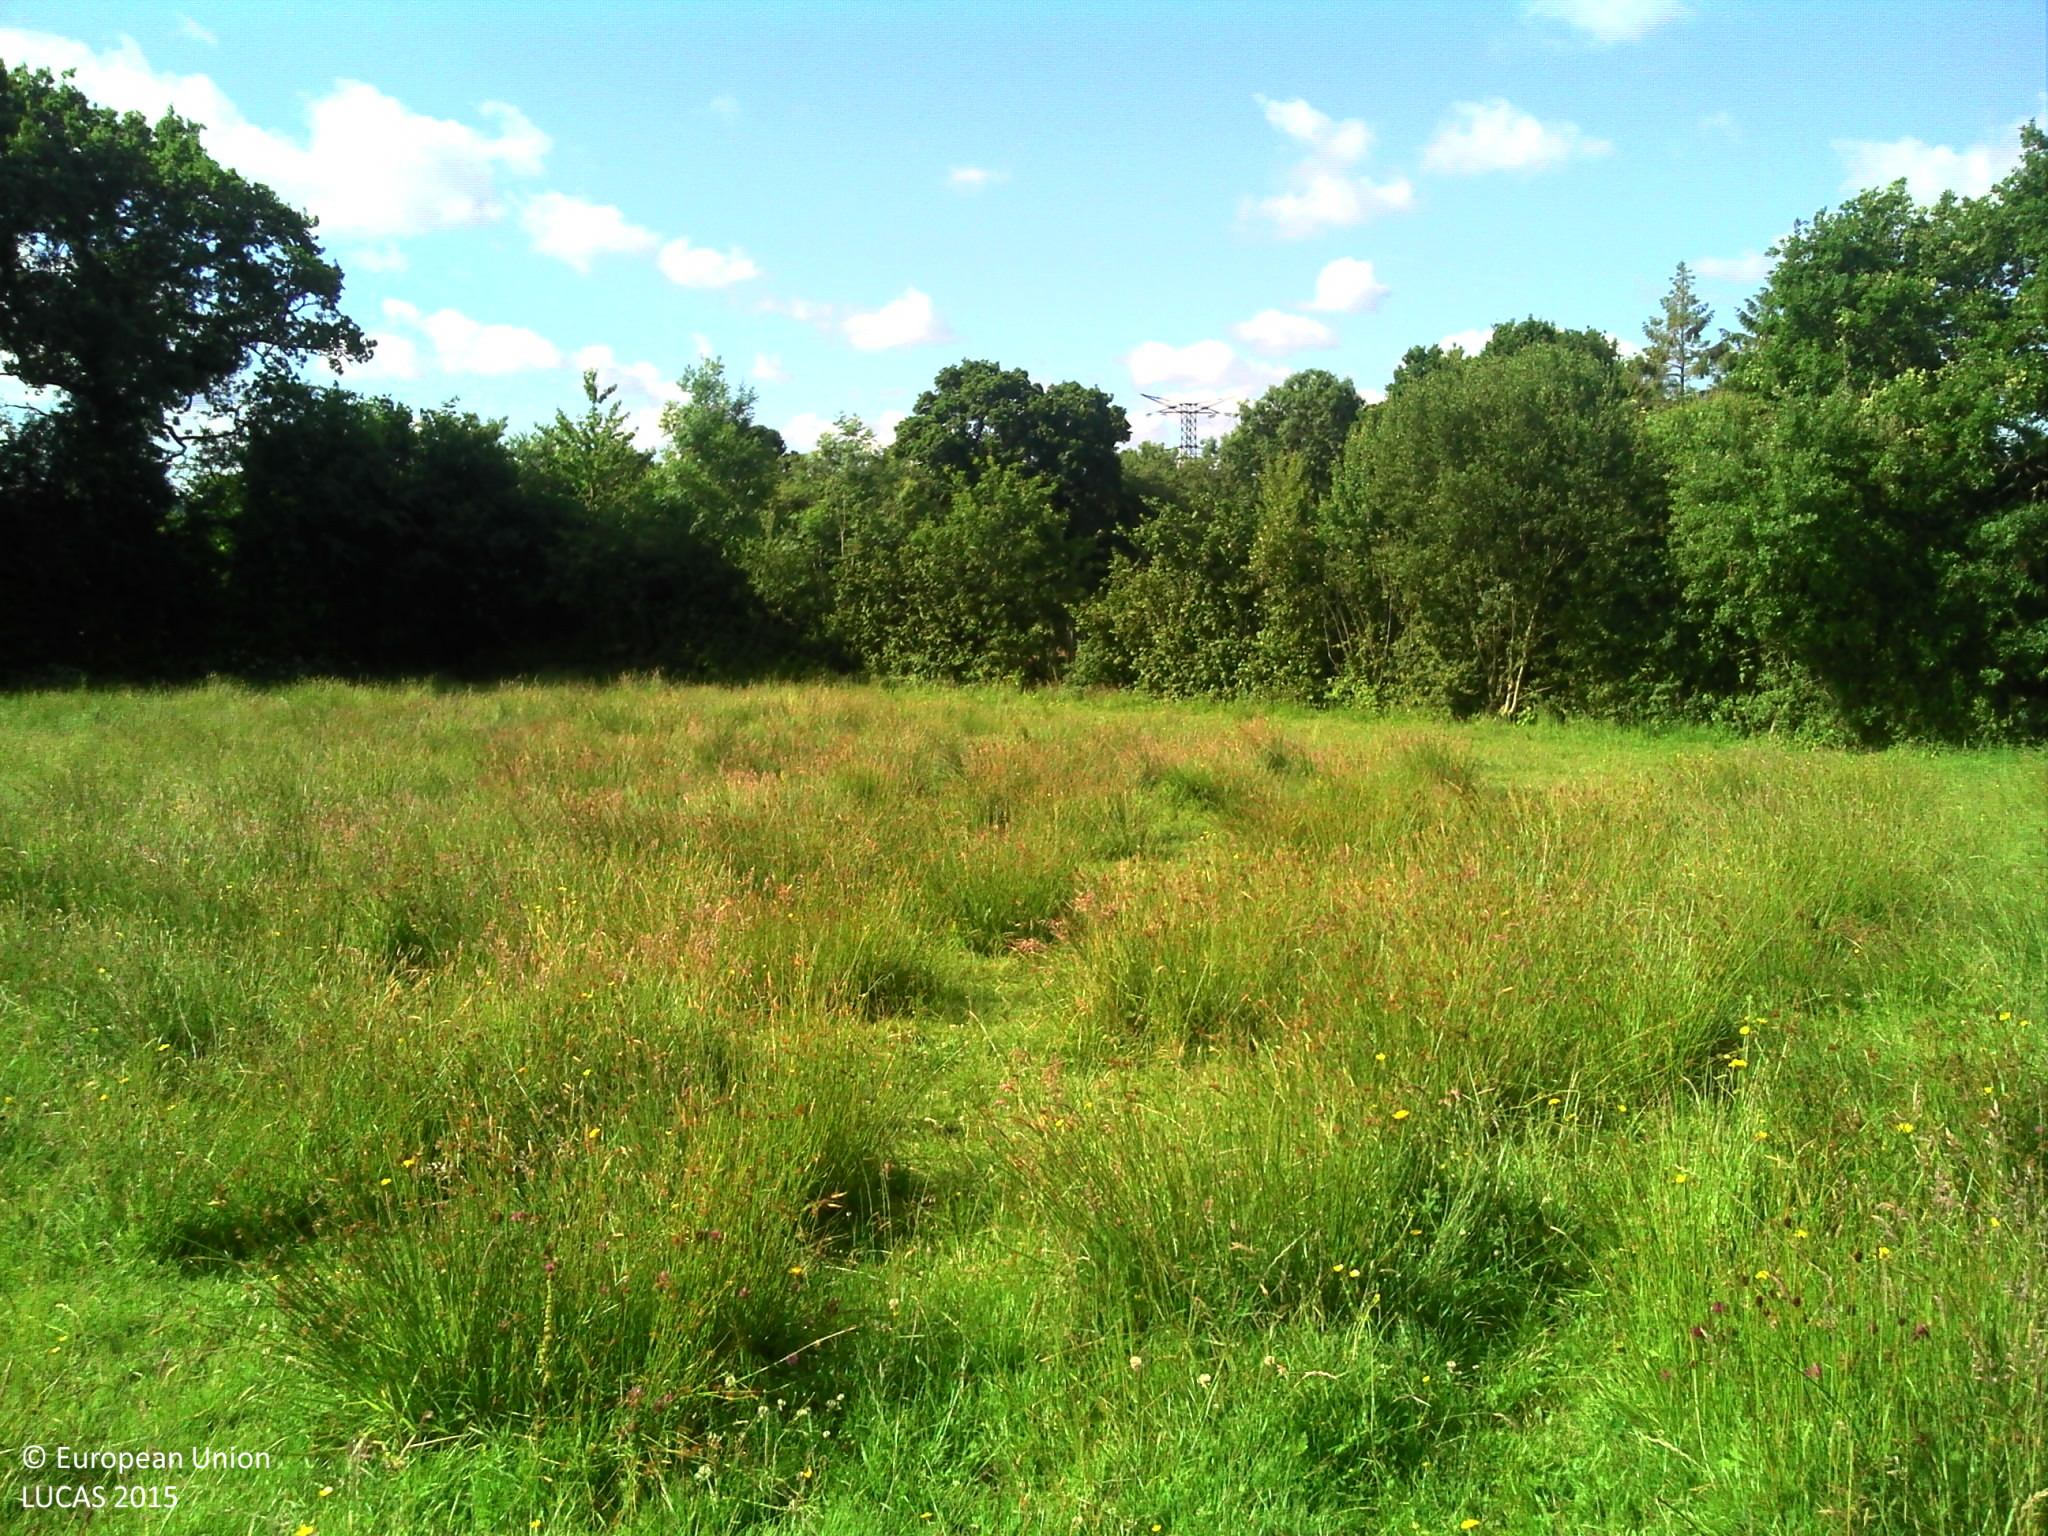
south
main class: Grassland
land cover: Grassland without tree/shrub cover
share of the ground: > 75 %
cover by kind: herbaceous plants 100 %
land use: Agriculture (excluding fallow land and kitchen gardens)
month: June
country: FR
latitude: 49.4124
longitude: -1.5591
